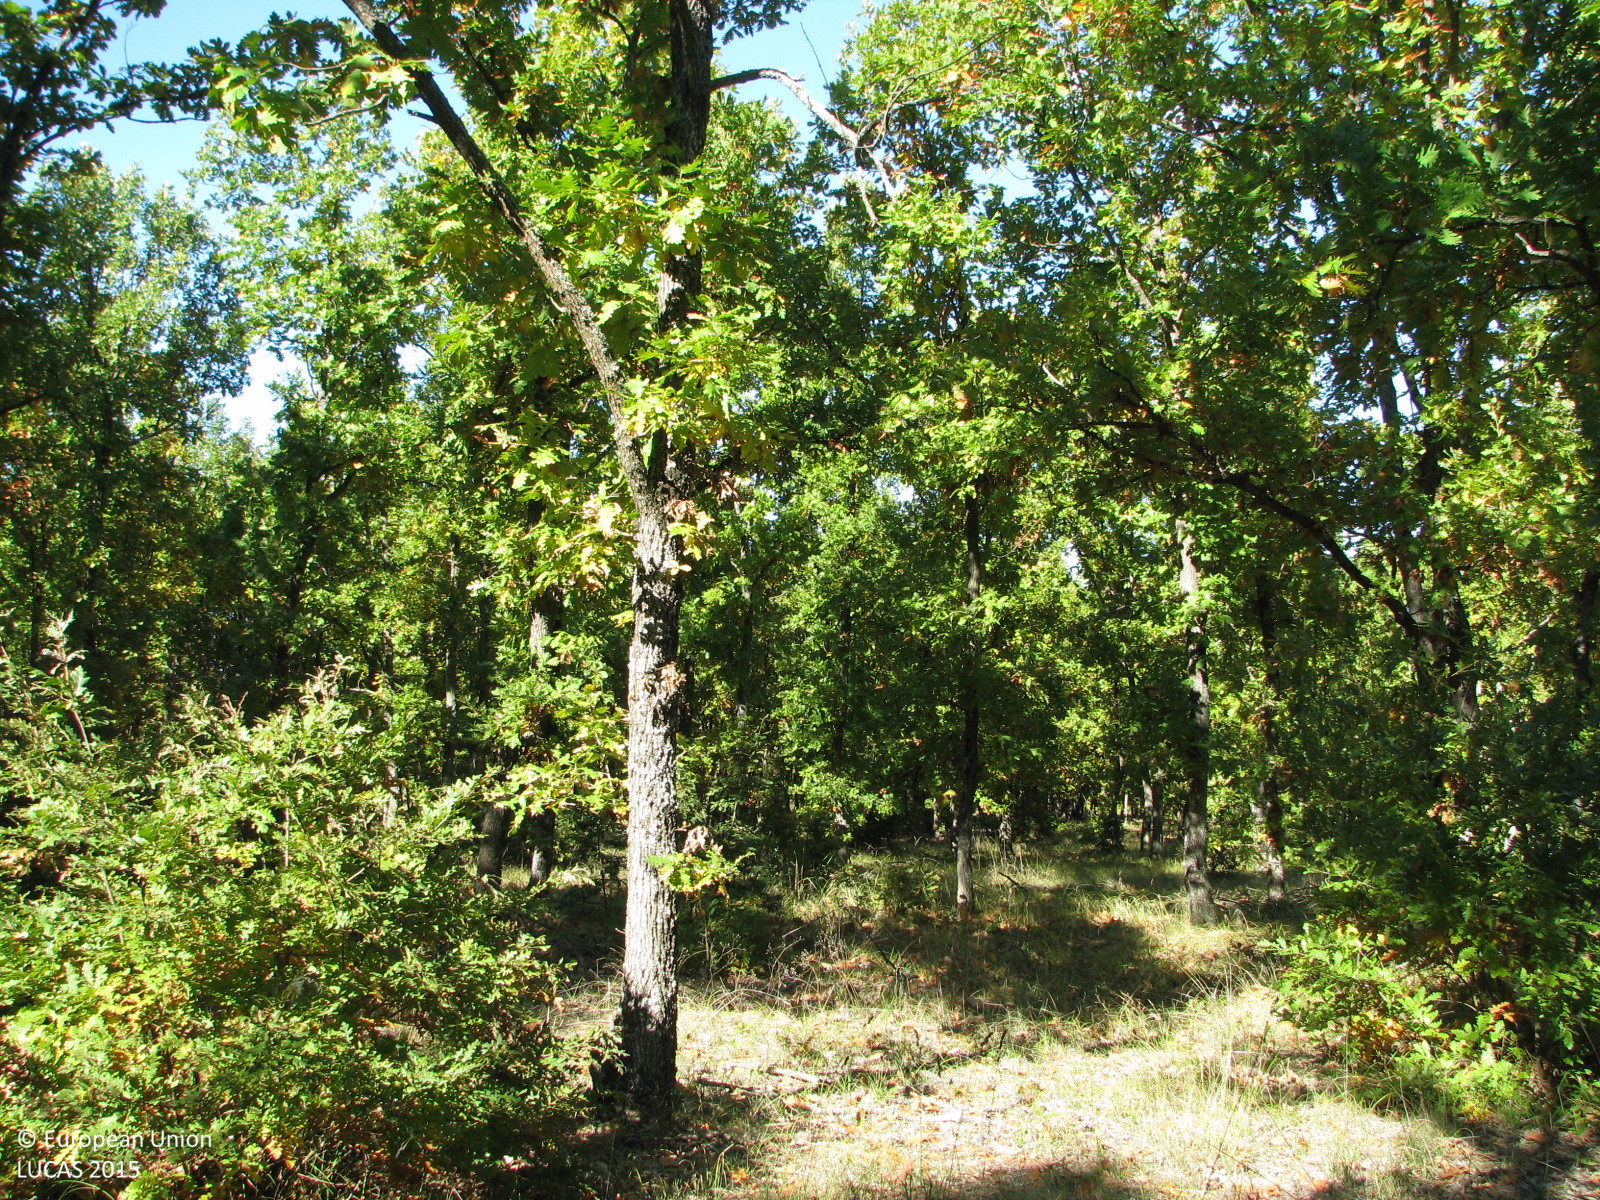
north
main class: Woodland
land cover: Broadleaved woodland
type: mesophytic deciduous forest
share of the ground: 50 - 75 %
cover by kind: broadleaved forest trees 70 %, herbaceous plants 25 %, shrubs 5 %
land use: Forestry
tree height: > 5 m
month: October
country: BG
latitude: 42.1566
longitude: 26.2634
